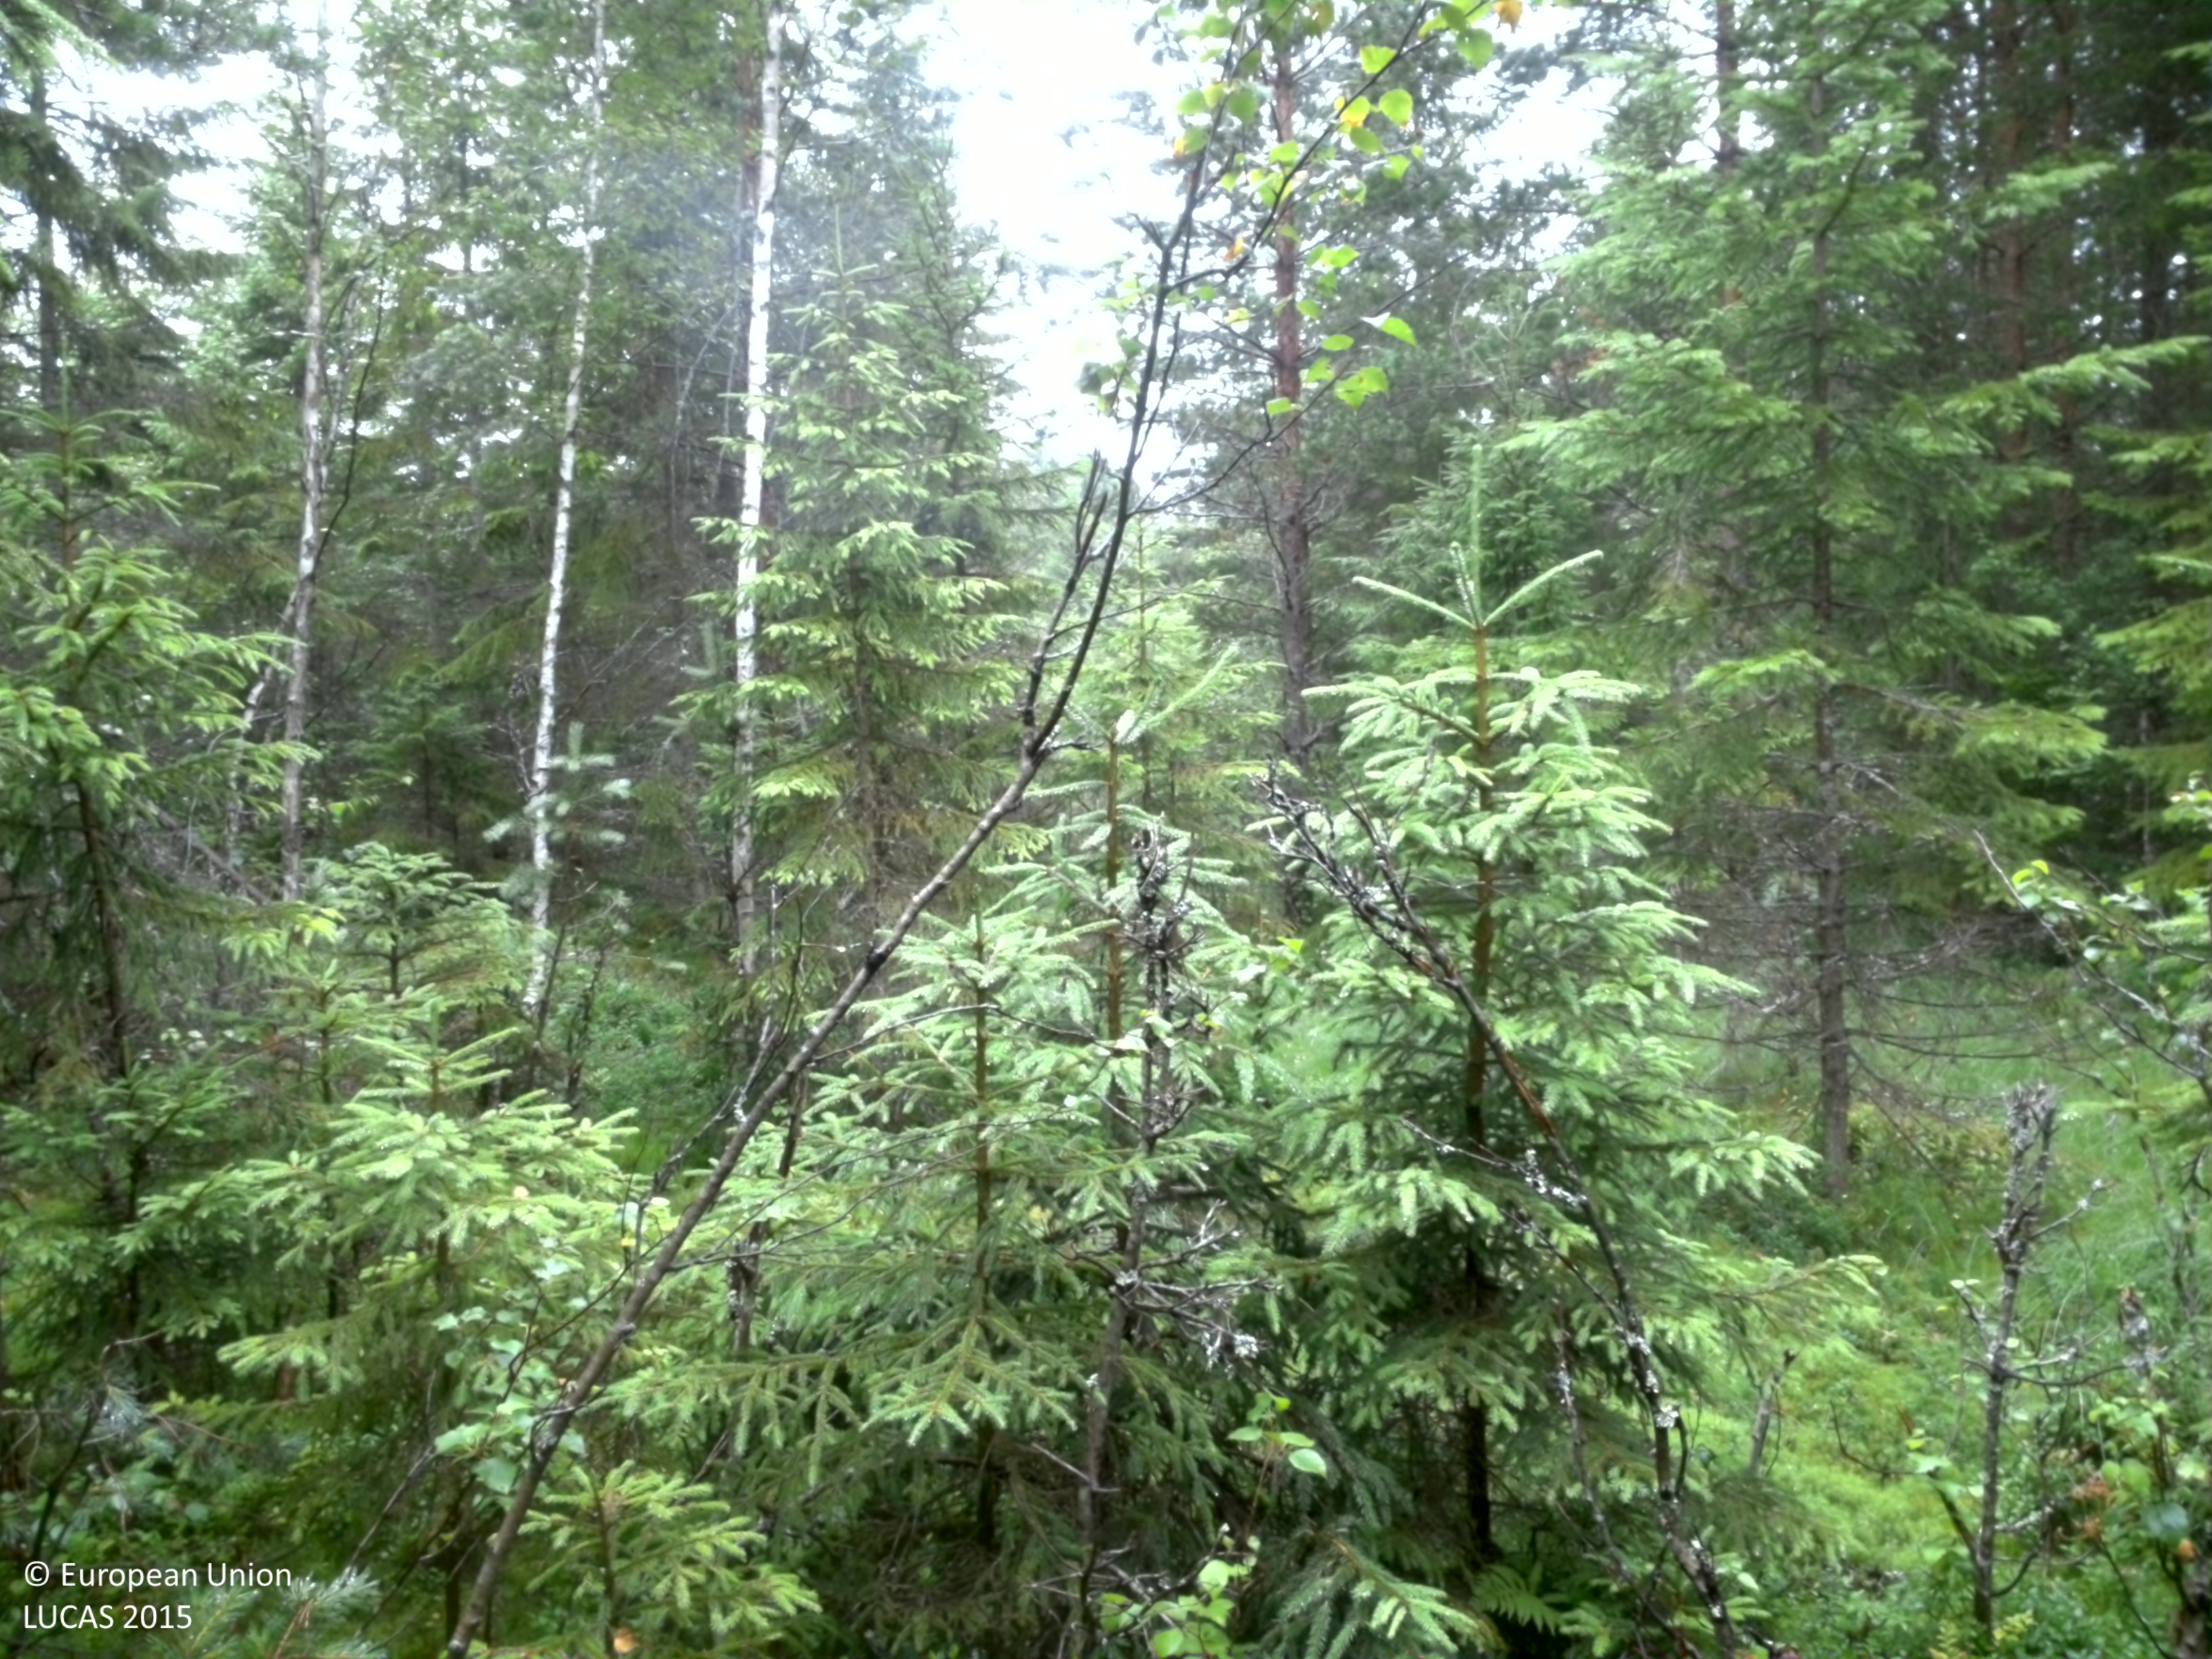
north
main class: Woodland
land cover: Other mixed woodland
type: boreal forest
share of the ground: 50 - 75 %
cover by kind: coniferous forest trees 45 %, broadleaved forest trees 20 %, lichens and mosses 15 %, shrubs 10 %, herbaceous plants 10 %
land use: Forestry
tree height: > 5 m
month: July
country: SE
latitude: 59.2725
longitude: 14.7115
